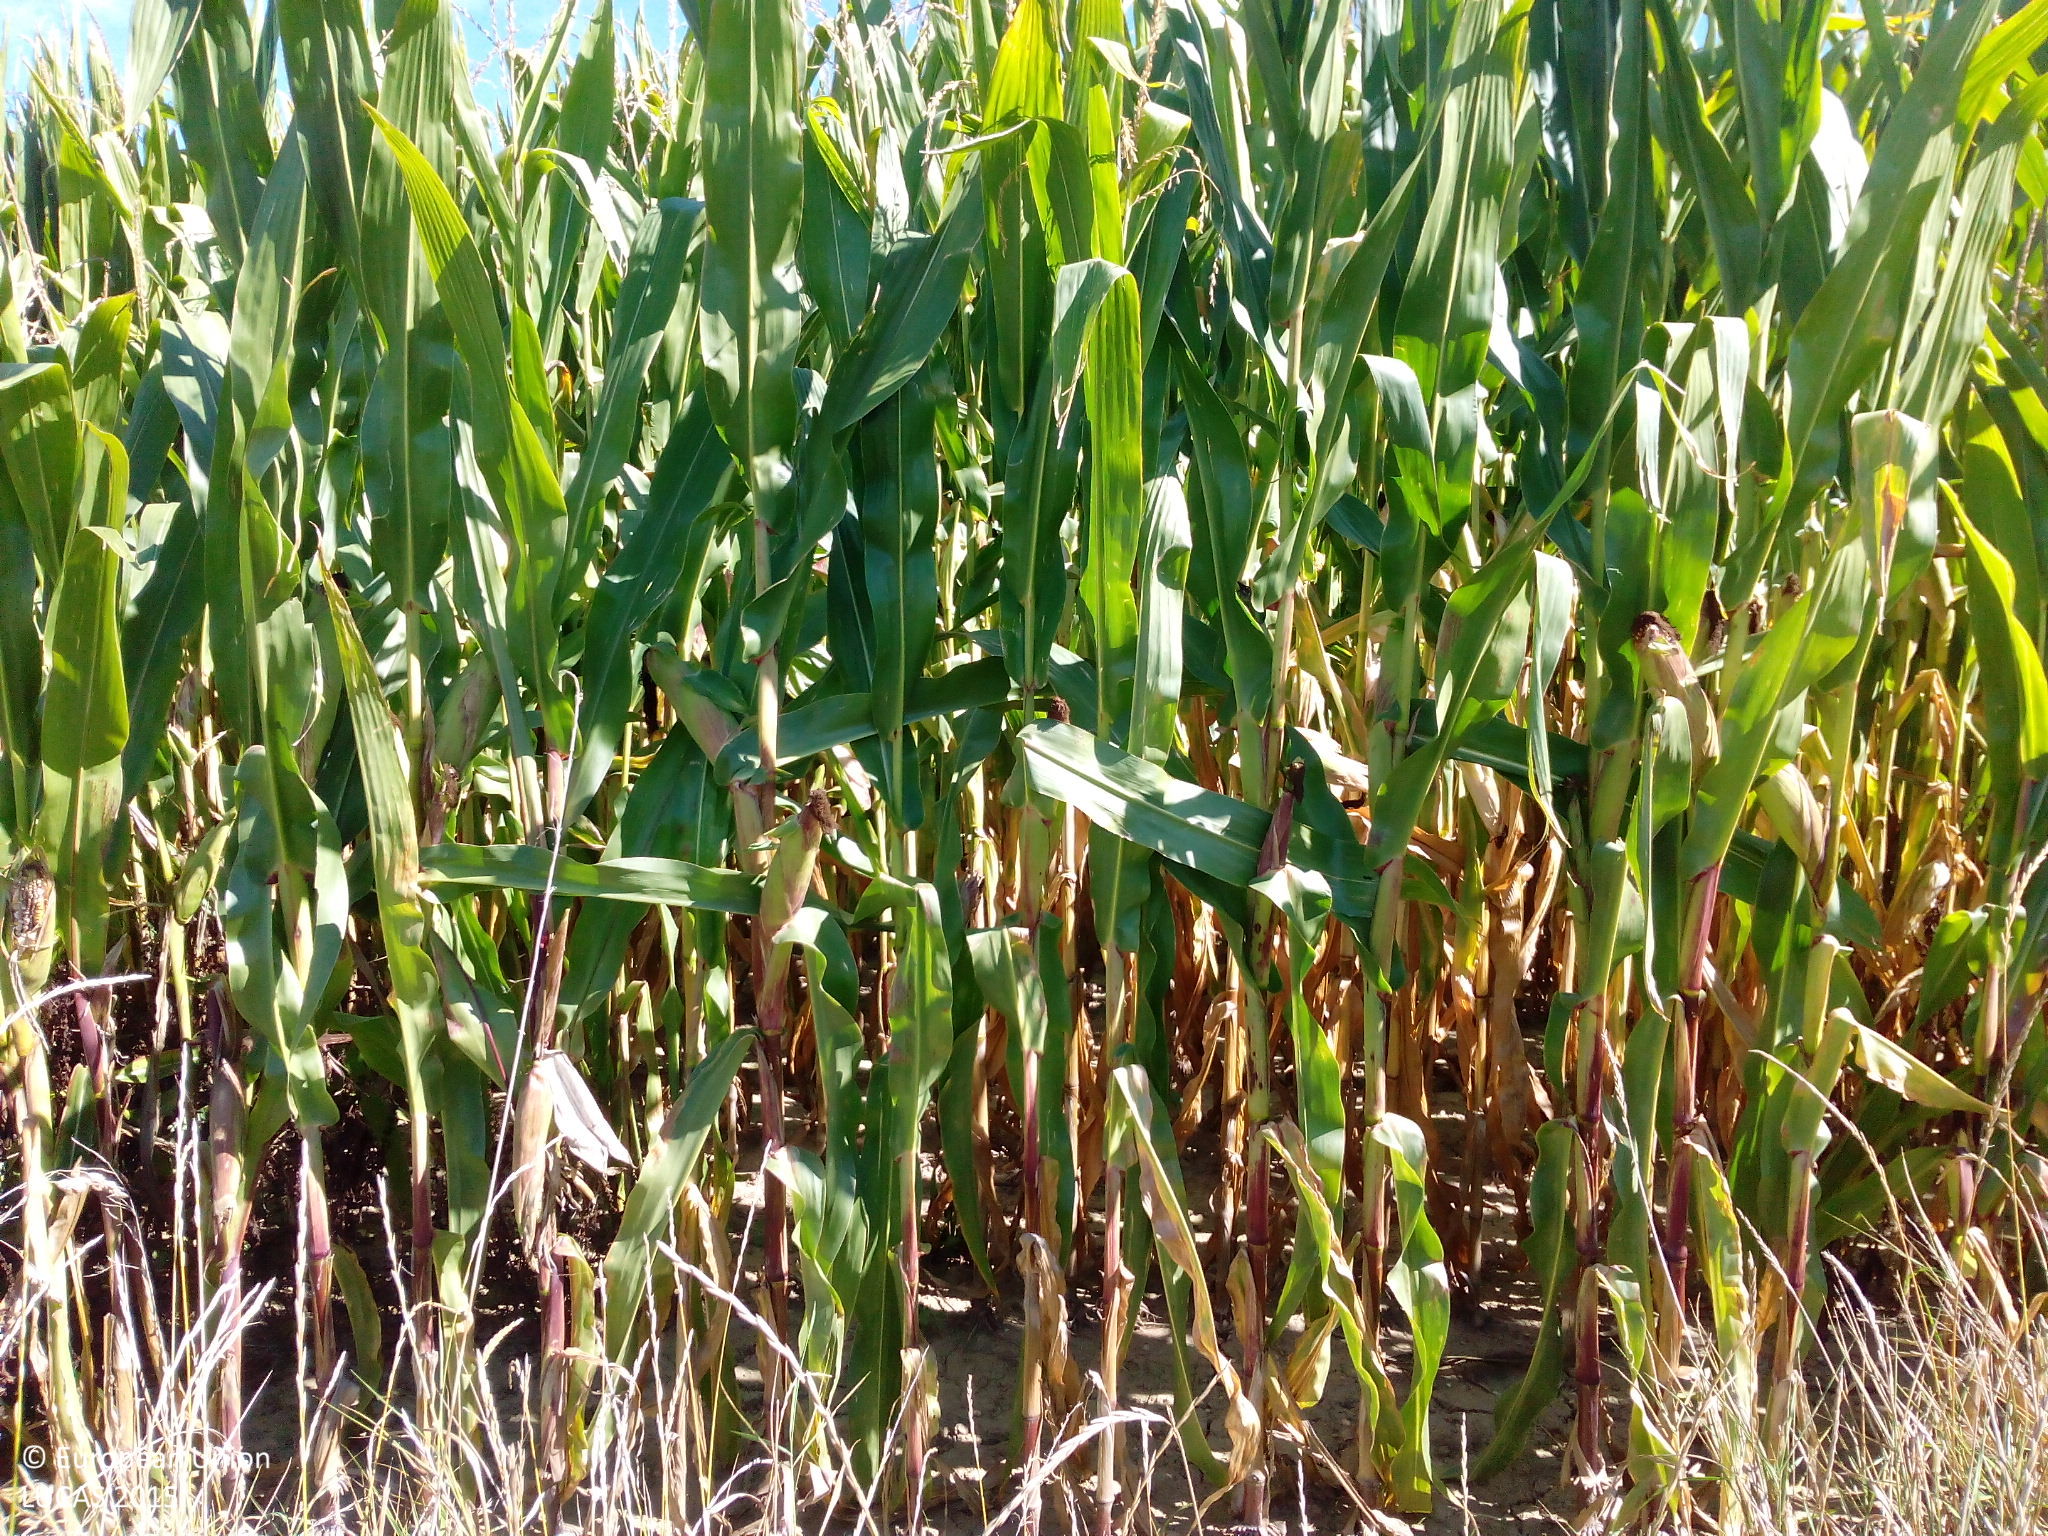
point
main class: Cropland
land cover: Maize
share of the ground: > 75 %
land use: Agriculture (excluding fallow land and kitchen gardens)
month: September
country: DE
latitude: 48.3842
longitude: 12.0650
